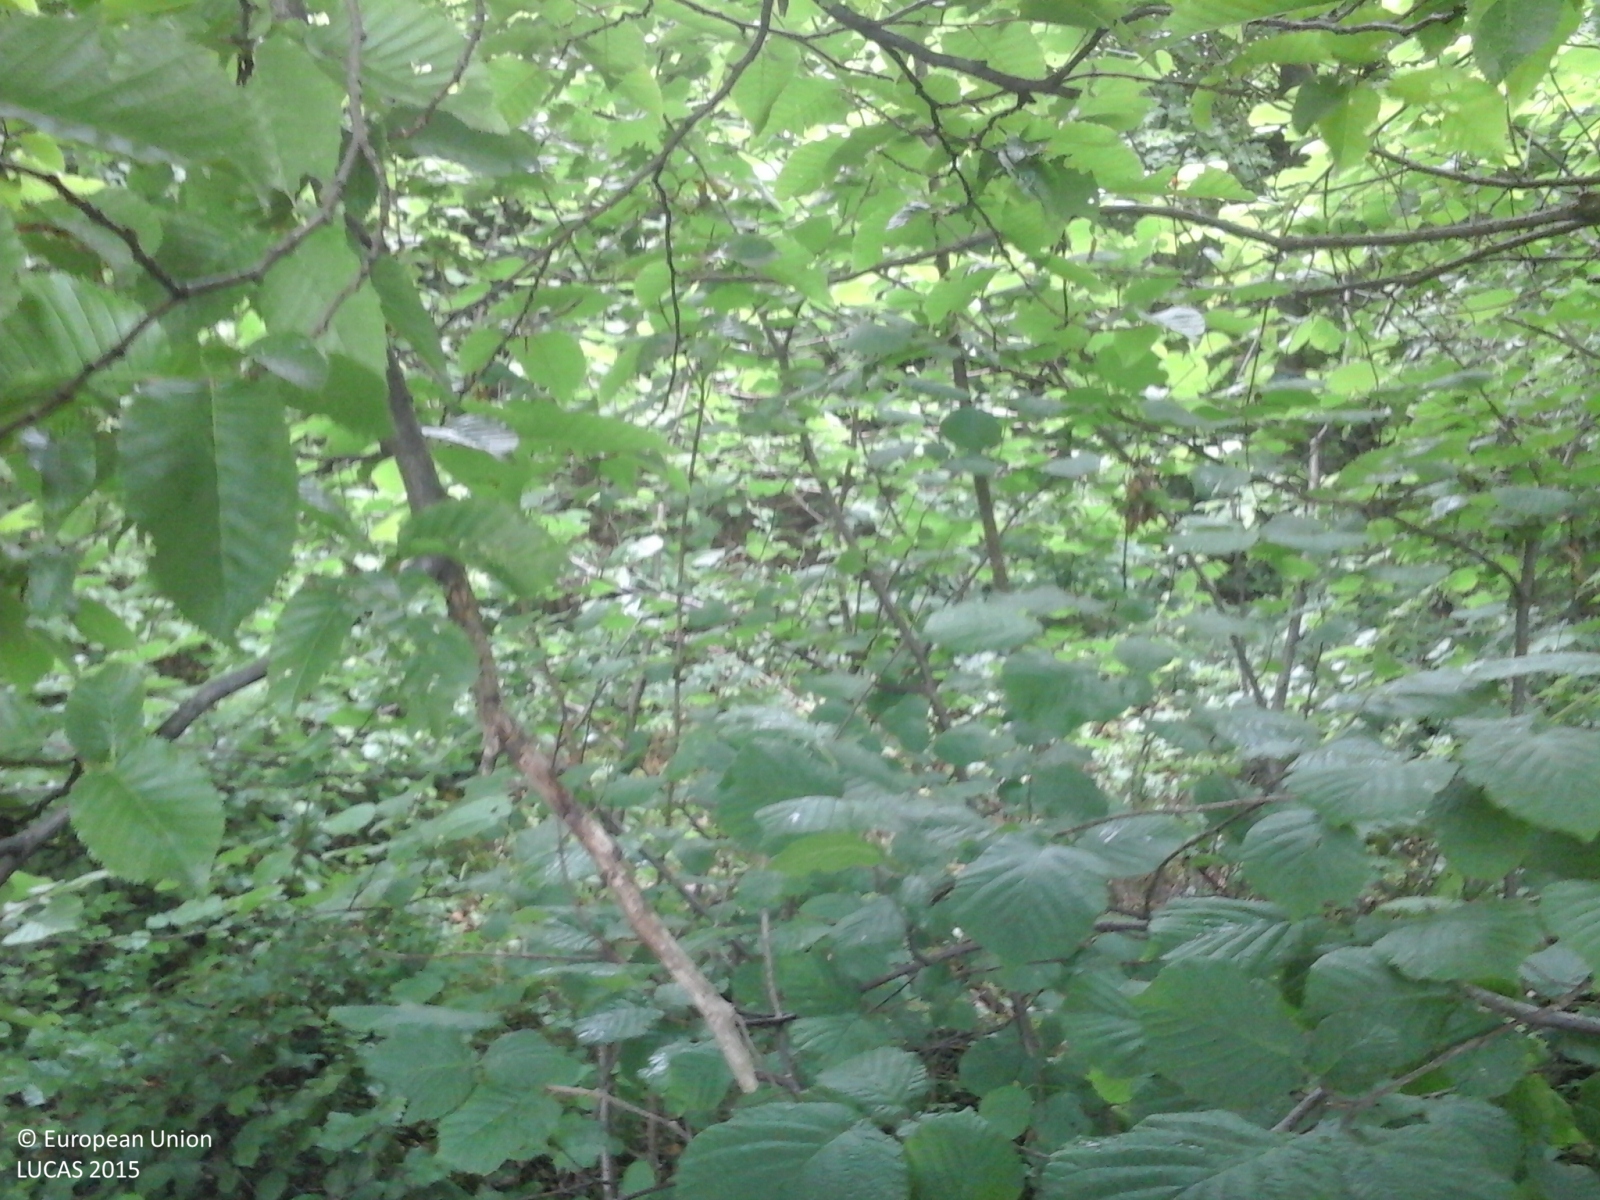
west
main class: Woodland
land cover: Broadleaved woodland
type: mesophytic deciduous forest
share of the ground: > 75 %
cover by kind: broadleaved forest trees 60 %, shrubs 40 %
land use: Forestry
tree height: > 5 m
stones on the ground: < 10 %
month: May
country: IT
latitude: 45.8424
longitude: 10.9642
